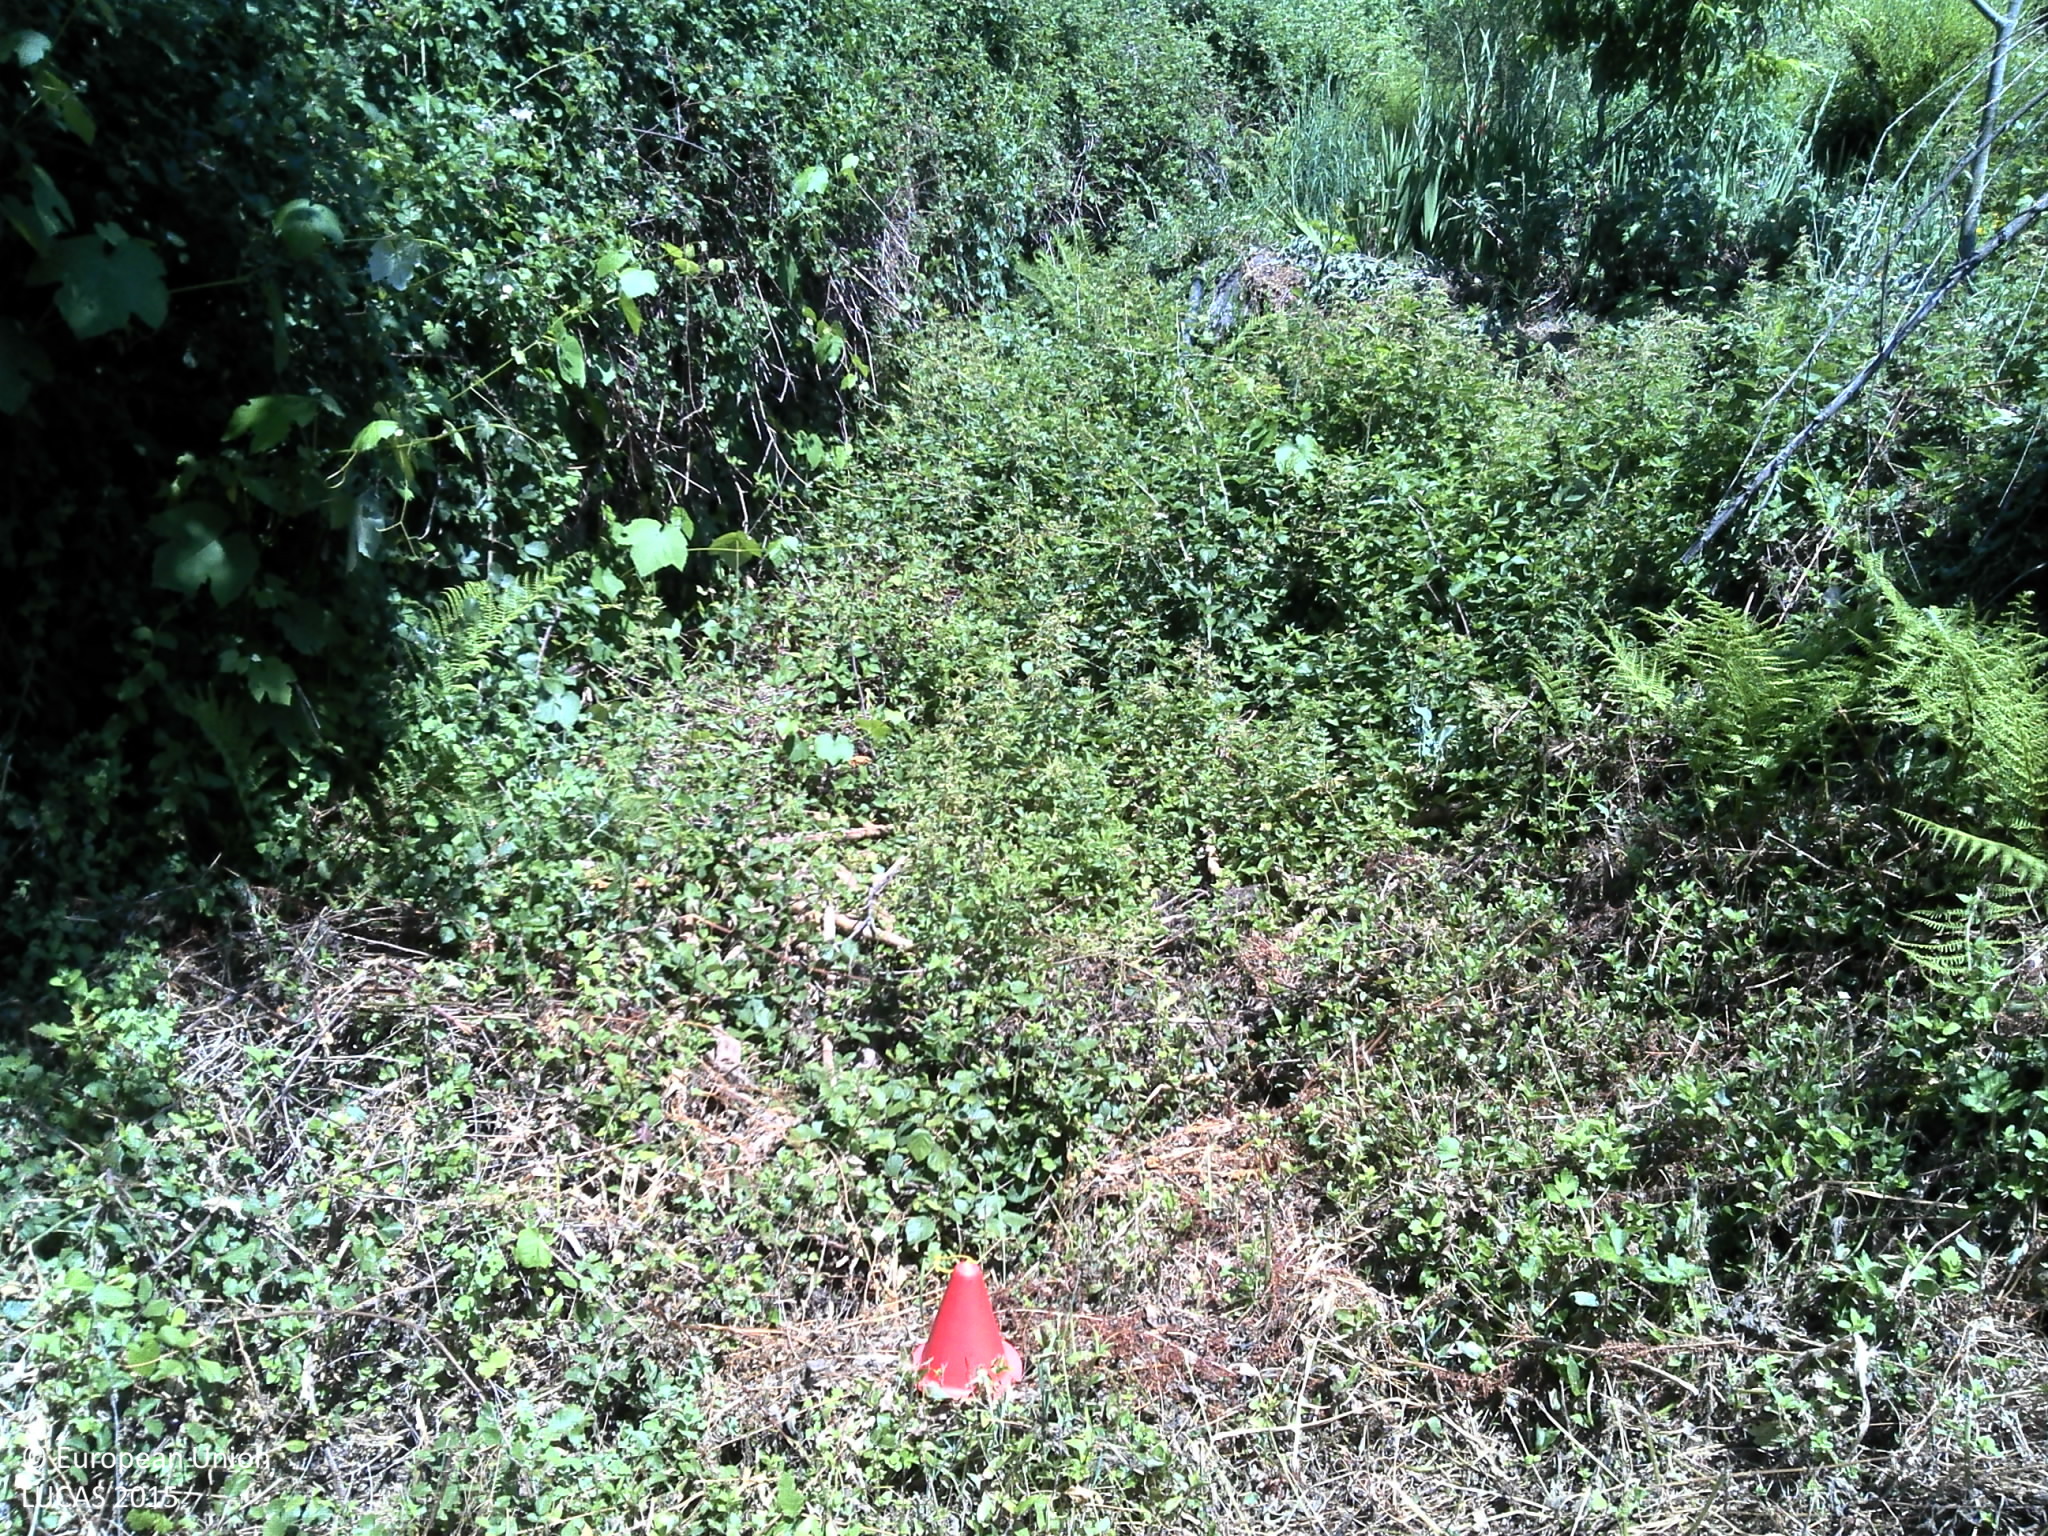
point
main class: Shrubland
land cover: Shrubland without tree cover
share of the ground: 50 - 75 %
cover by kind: shrubs 50 %, herbaceous plants 40 %, consolidated bare surface 10 %
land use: Abandoned areas
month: June
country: PT
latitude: 41.9903
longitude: -8.4741
